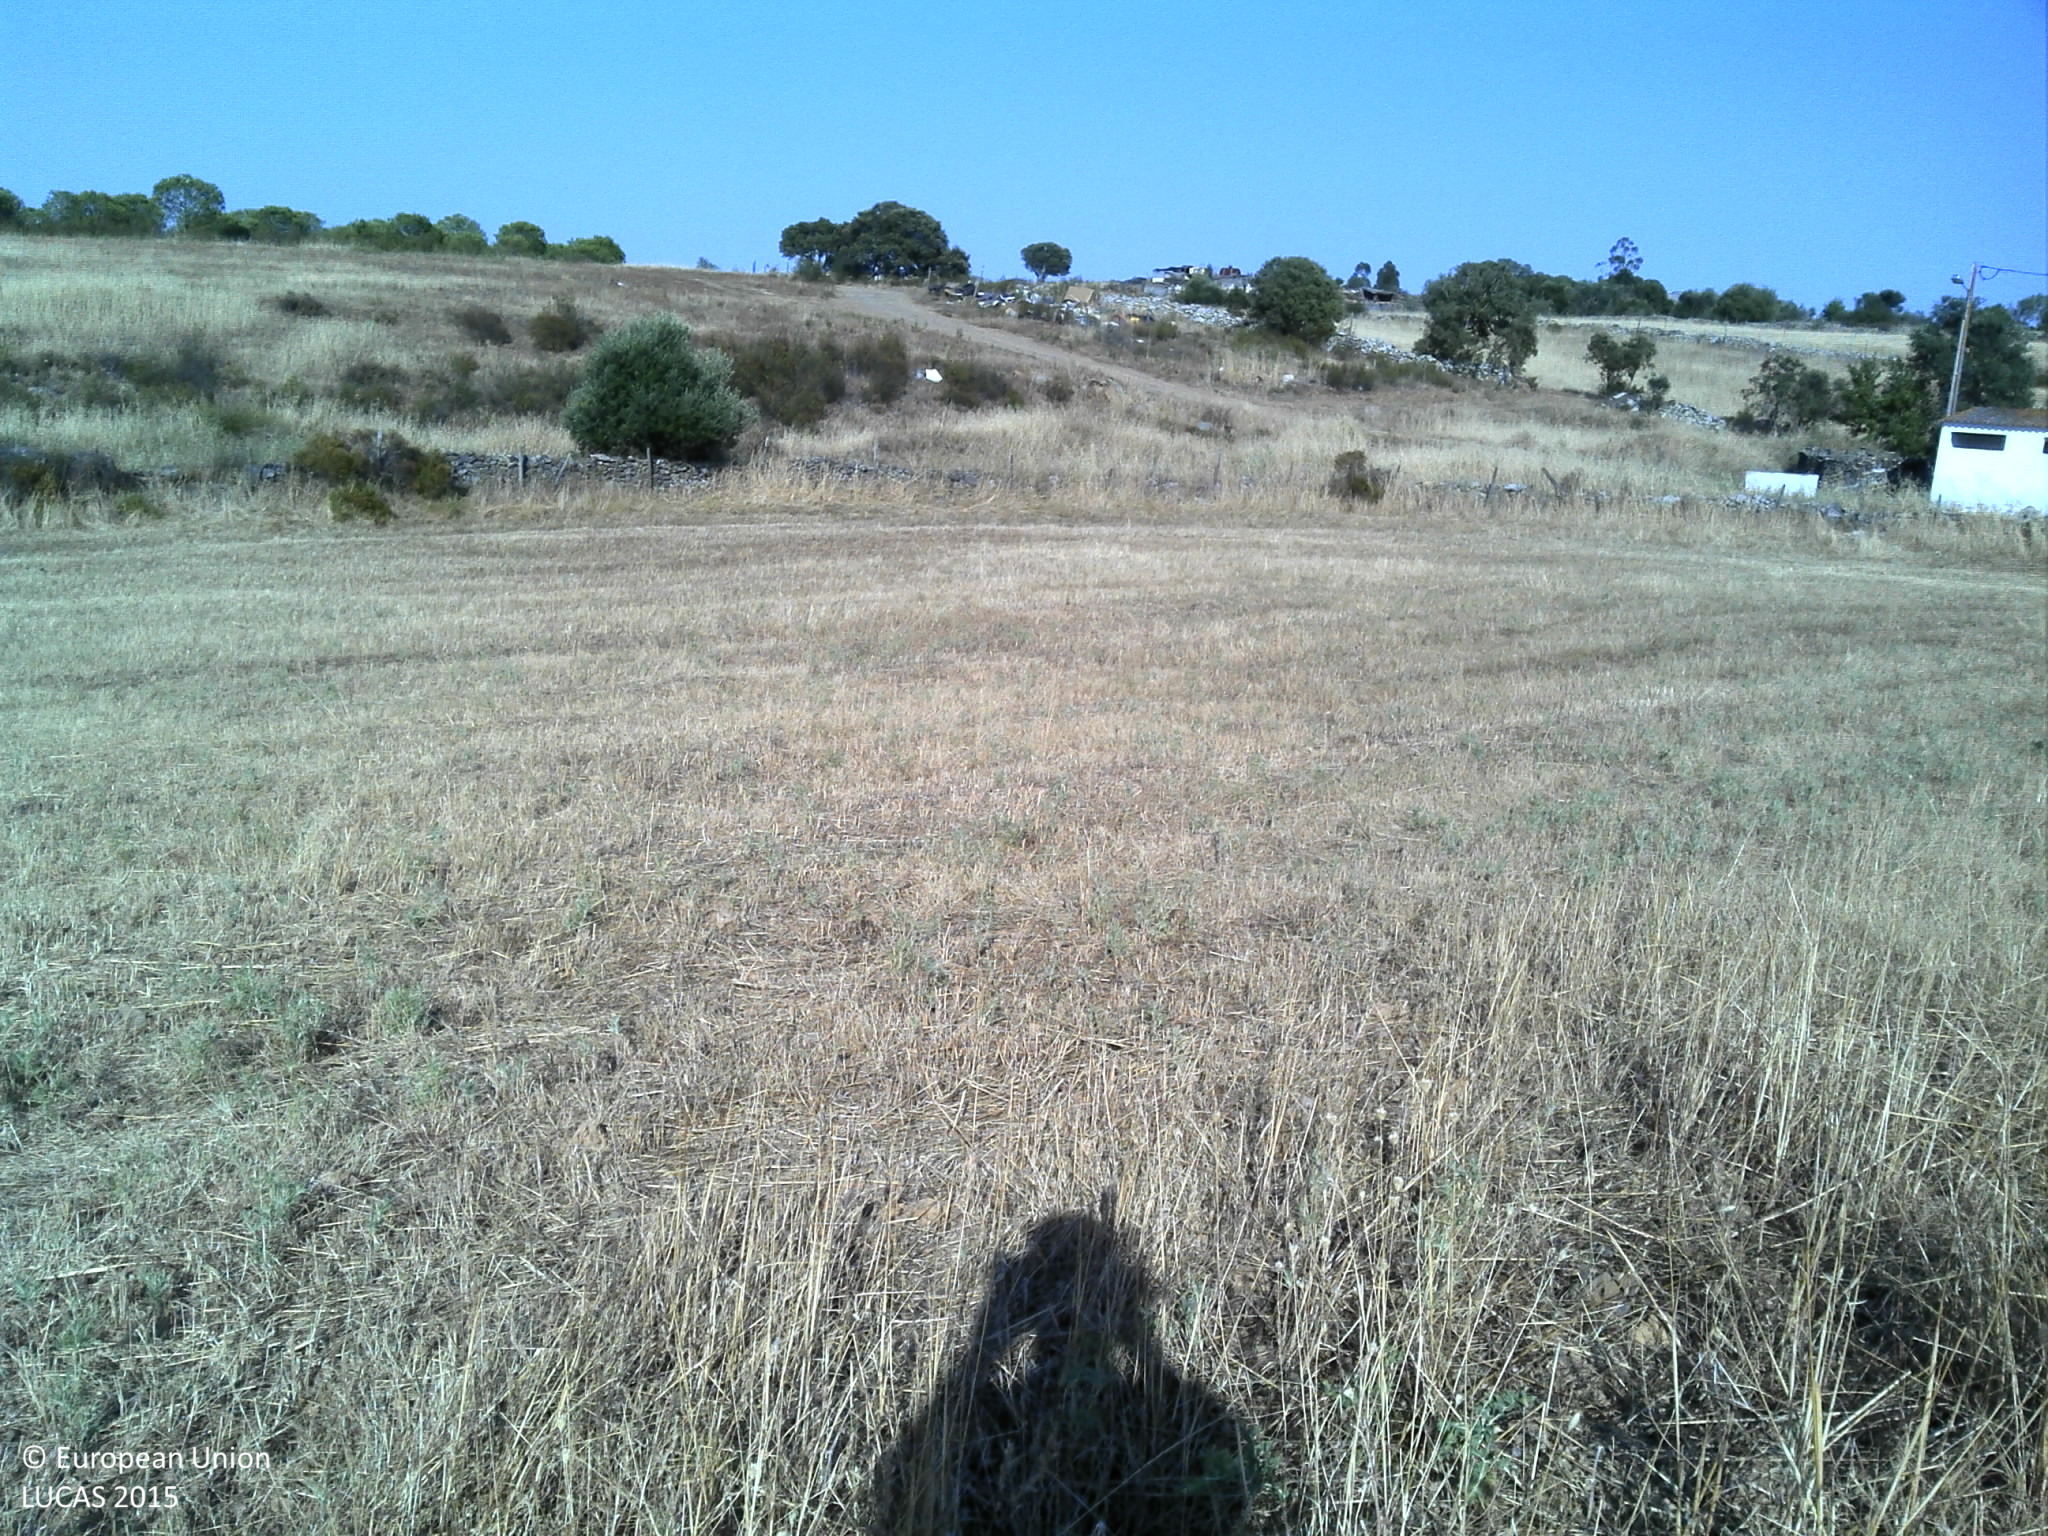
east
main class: Grassland
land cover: Grassland without tree/shrub cover
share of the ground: > 75 %
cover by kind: herbaceous plants 100 %
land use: Agriculture (excluding fallow land and kitchen gardens)
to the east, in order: Grassland without tree/shrub cover; Fences; Dry stone walls; Shruby margins; Rivers and streams; Shruby margins; Shrubland without tree cover; Grassland without tree/shrub cover; Tracks; Grassland without tree/shrub cover; Tracks; Grassland without tree/shrub cover
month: June
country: PT
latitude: 37.4611
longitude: -7.8913
